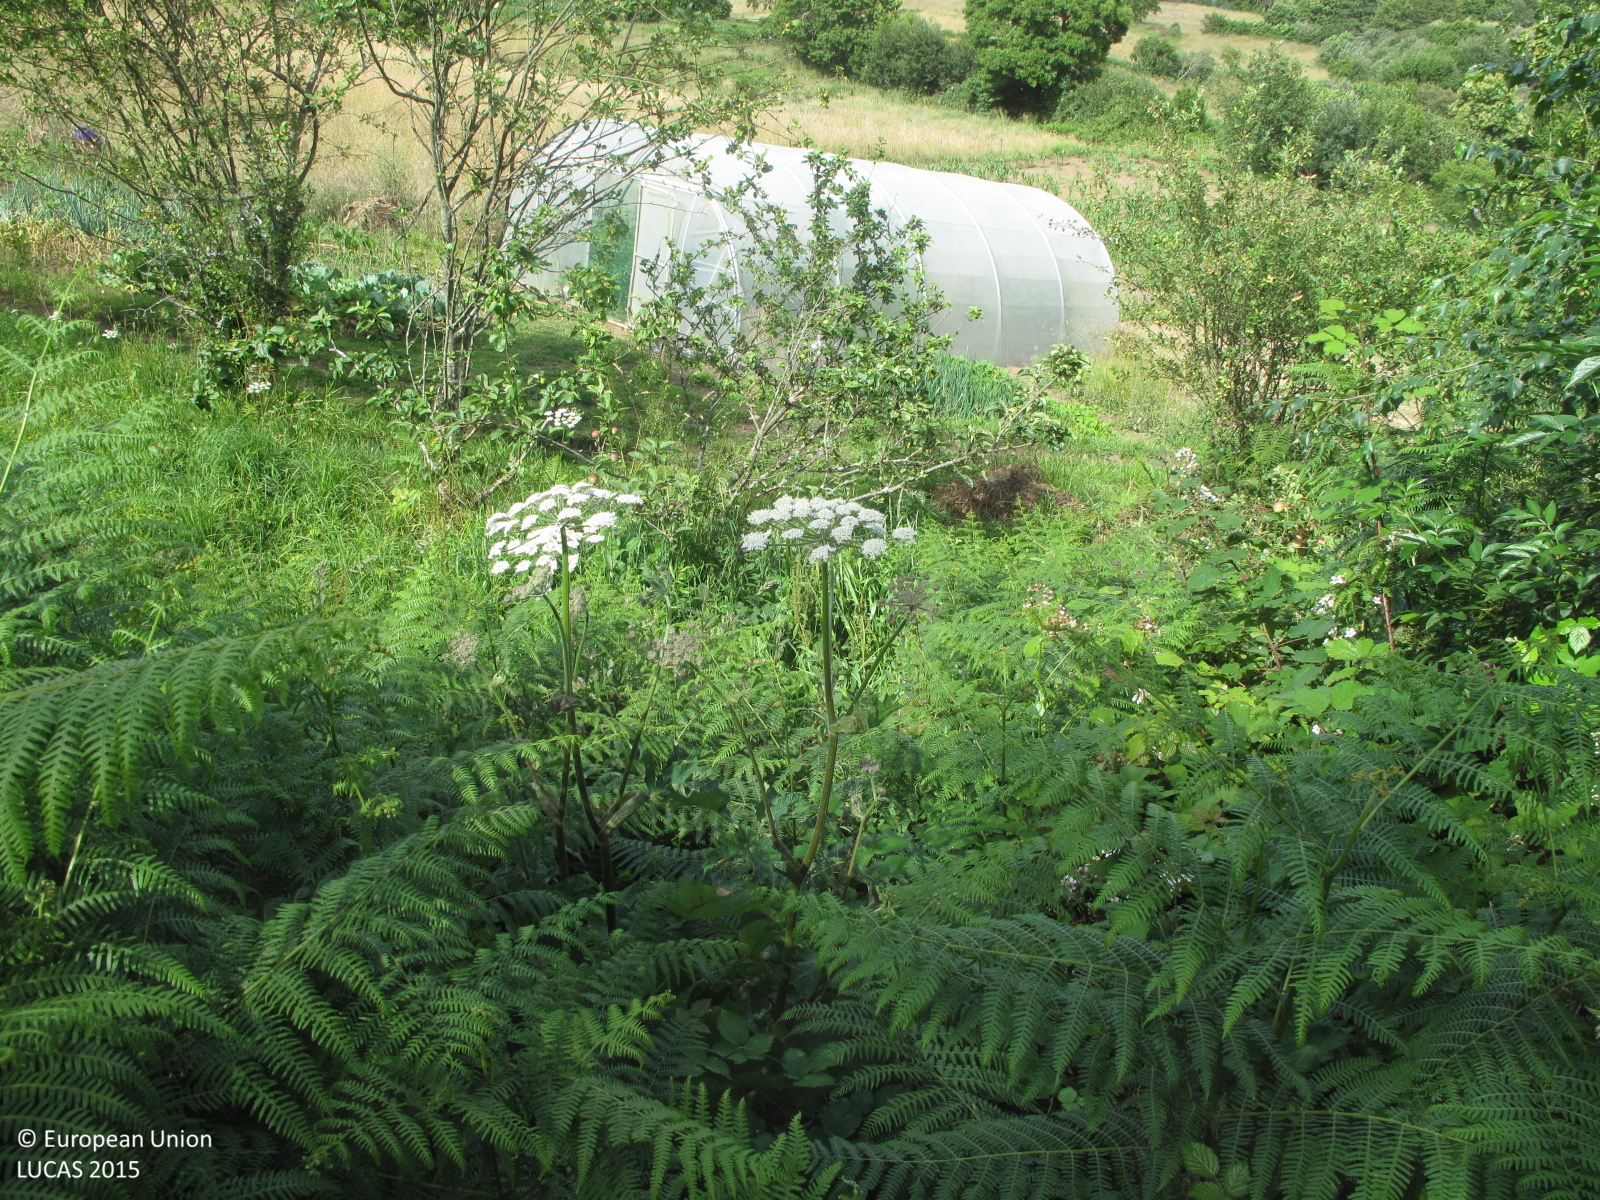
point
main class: Grassland
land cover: Grassland with sparse tree/shrub cover
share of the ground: > 75 %
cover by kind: herbaceous plants 90 %, broadleaved forest trees 5 %, shrubs 5 %
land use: Abandoned areas
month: July
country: ES
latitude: 43.2163
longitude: -8.5371
